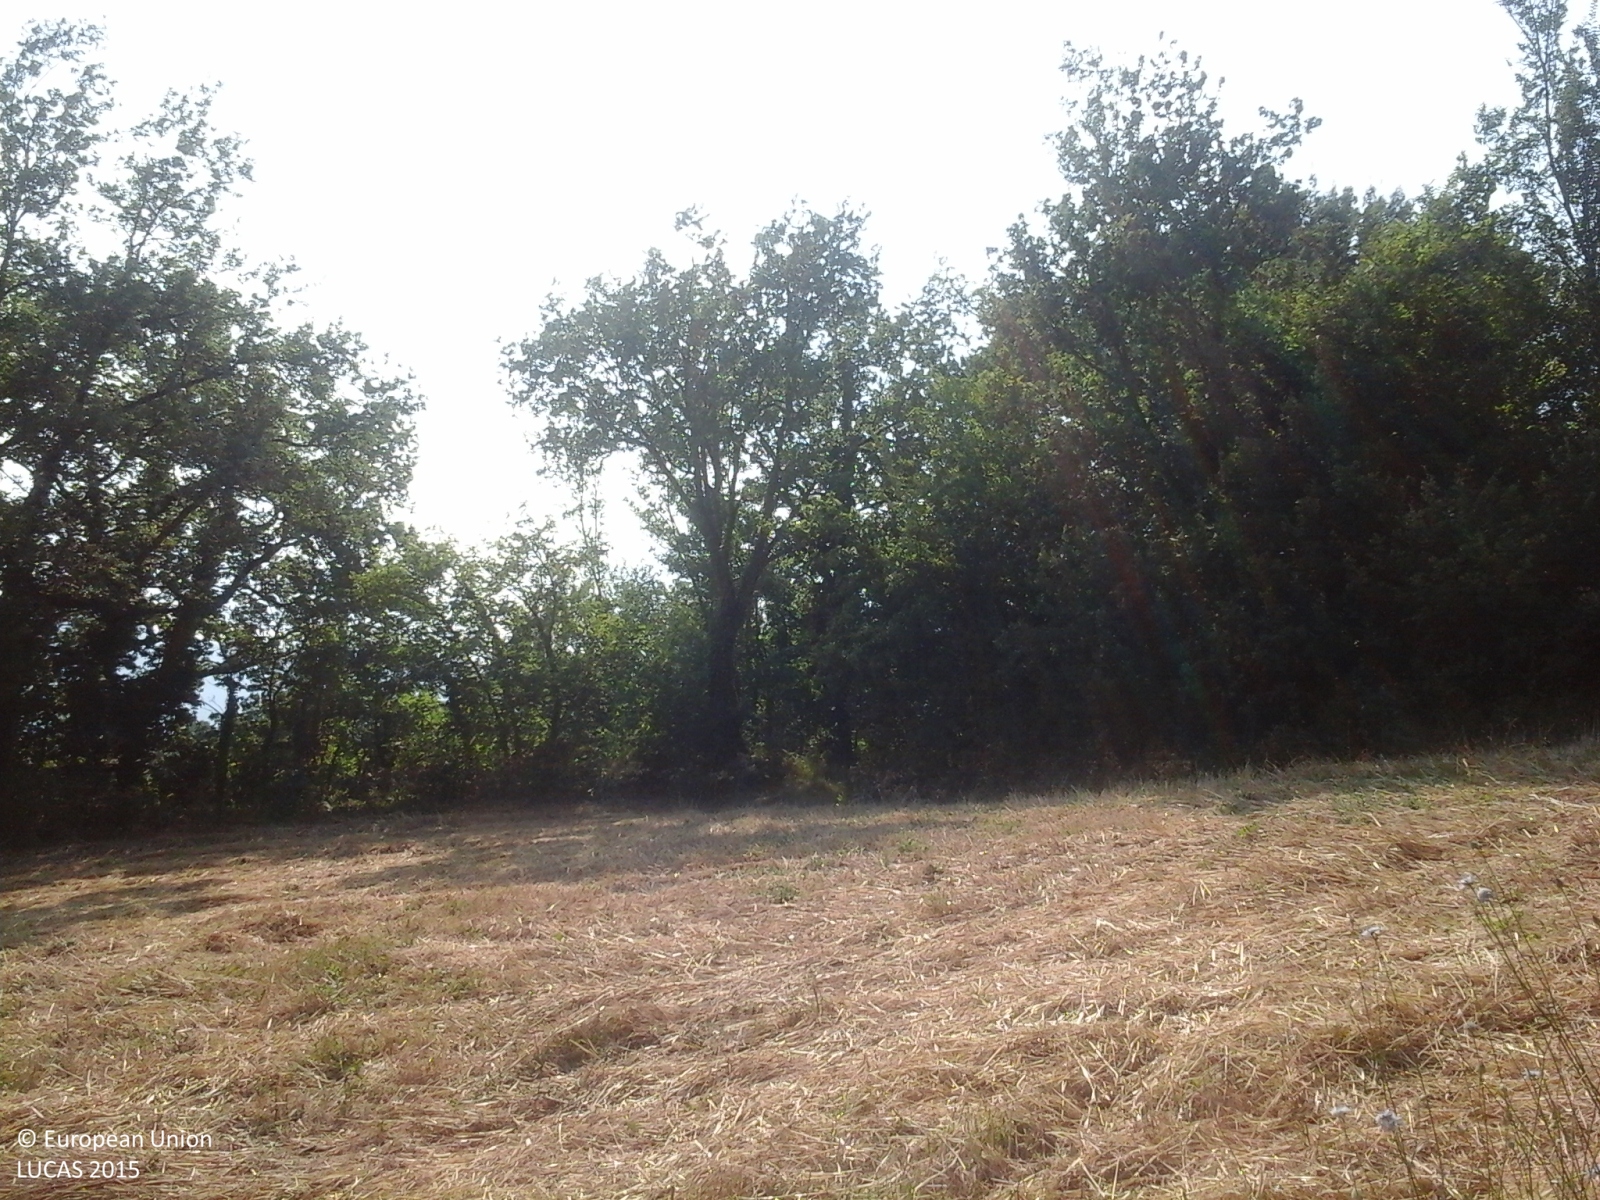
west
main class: Shrubland
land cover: Shrubland without tree cover
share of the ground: > 75 %
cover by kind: shrubs 95 %, herbaceous plants 5 %
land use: Semi-natural and natural areas not in use
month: July
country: IT
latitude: 43.0515
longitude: 13.3179
